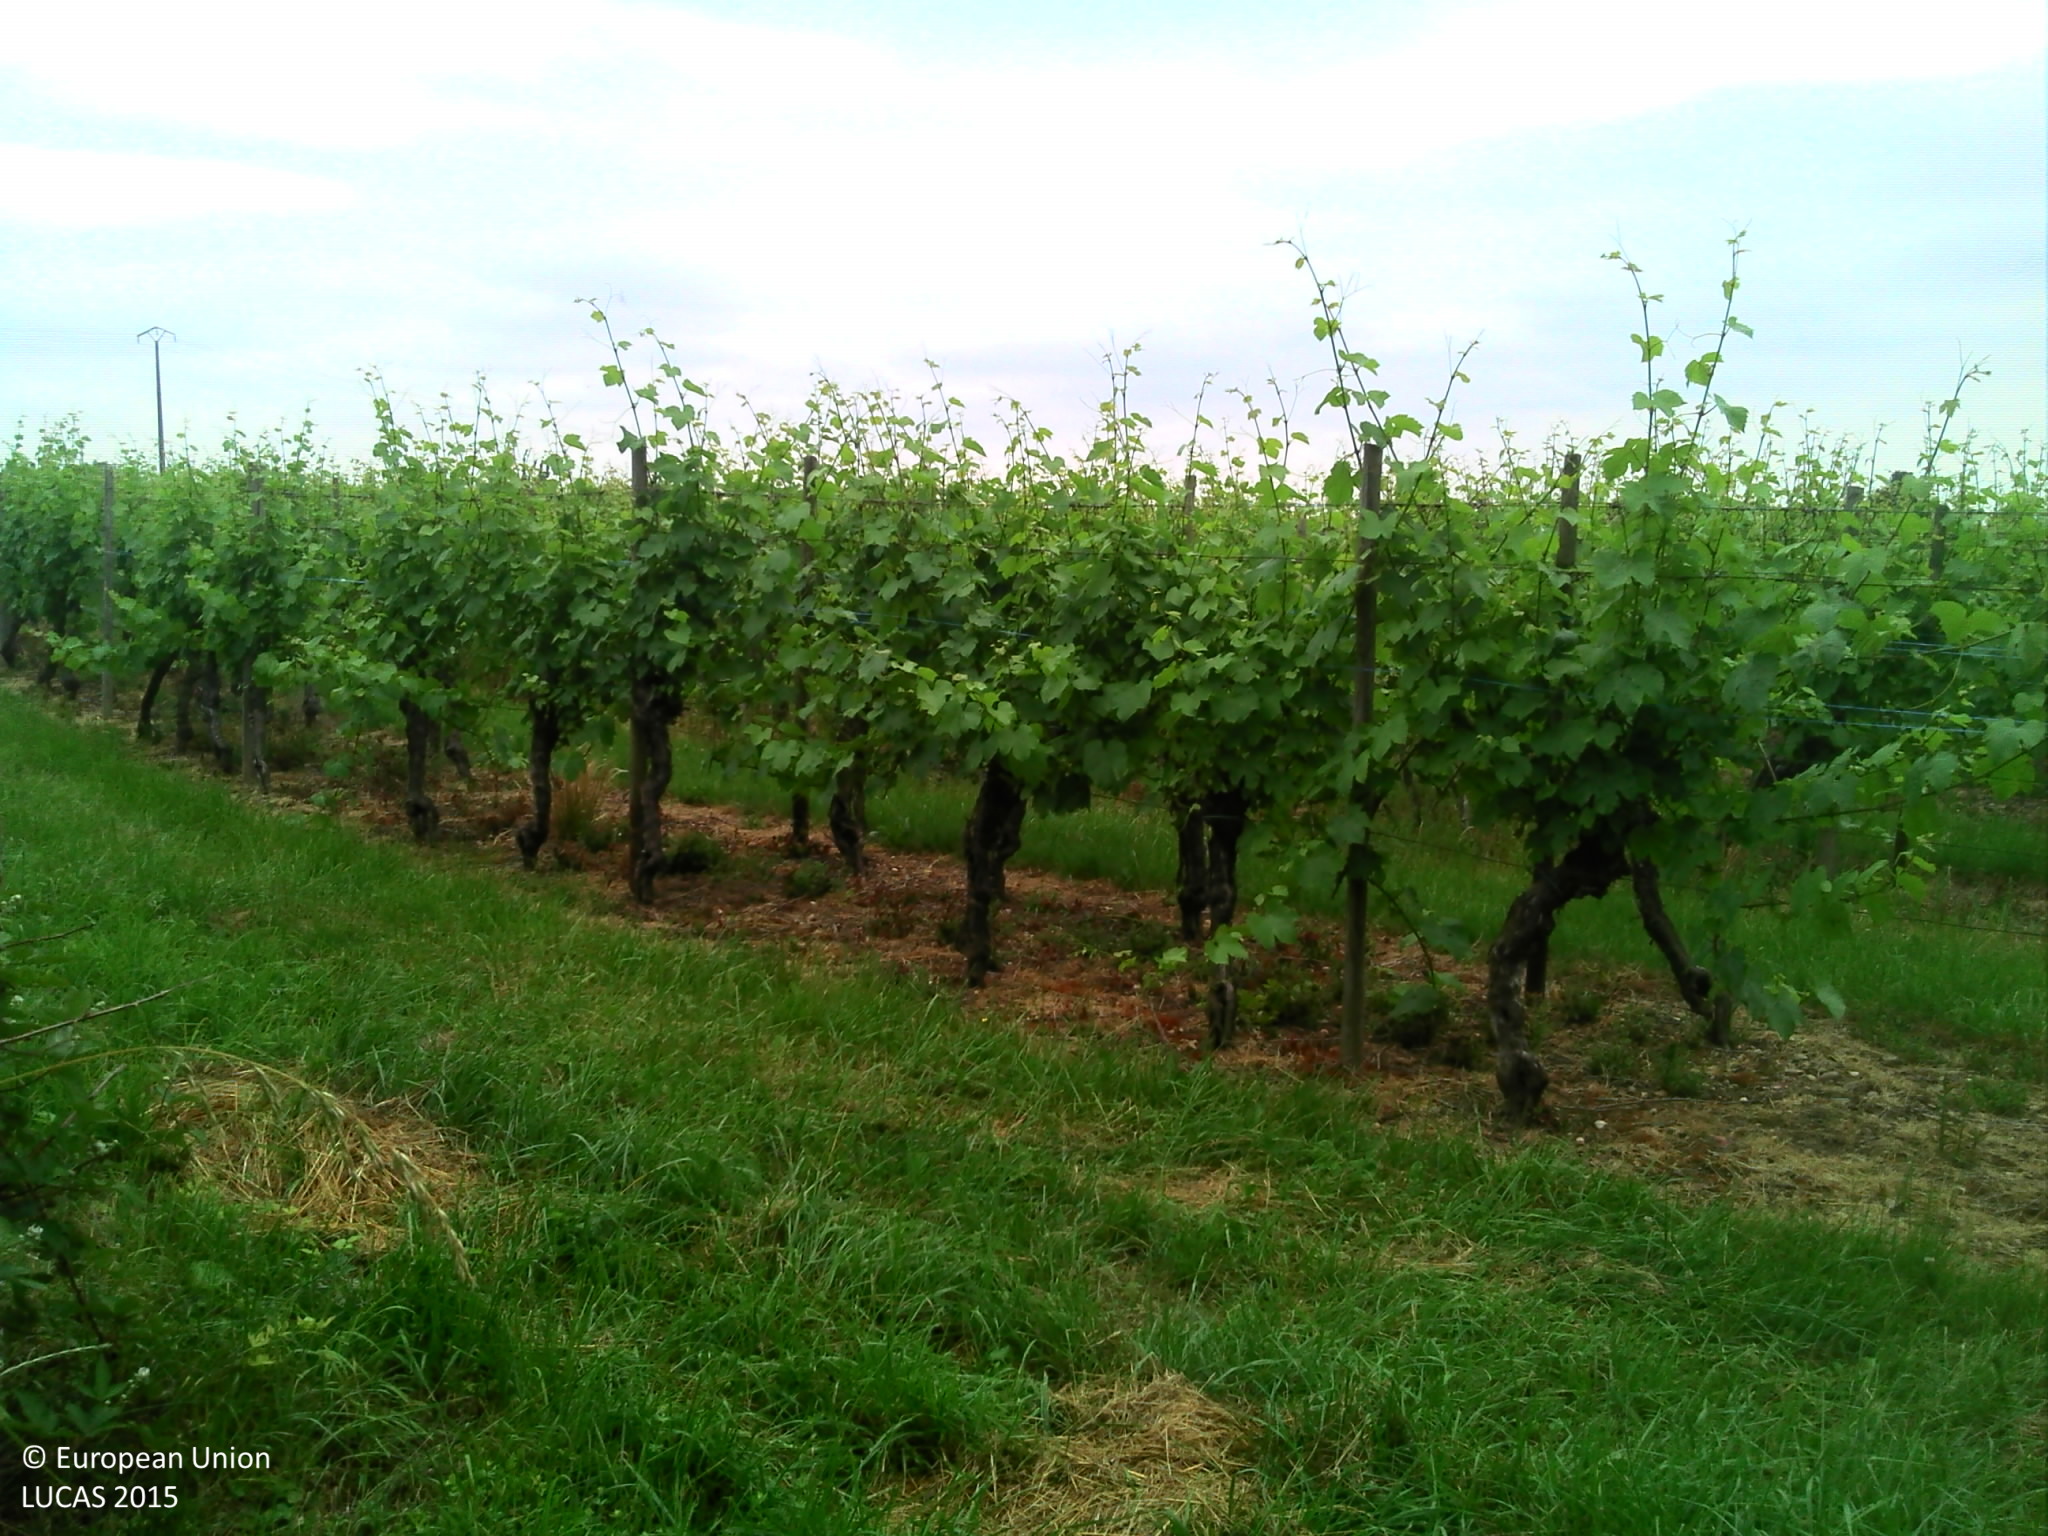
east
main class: Grassland
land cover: Spontaneously vegetated surfaces
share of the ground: > 75 %
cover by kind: herbaceous plants 95 %, shrubs 5 %
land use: Semi-natural and natural areas not in use
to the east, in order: Spontaneously vegetated surfaces; Vineyards; Grass margins; Abandoned hedges; Grassland without tree/shrub cover; Vineyards; Grass margins; Common wheat; Grass margins; Tracks; Grass margins; Vineyards
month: June
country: FR
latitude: 48.4466
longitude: 7.4727
